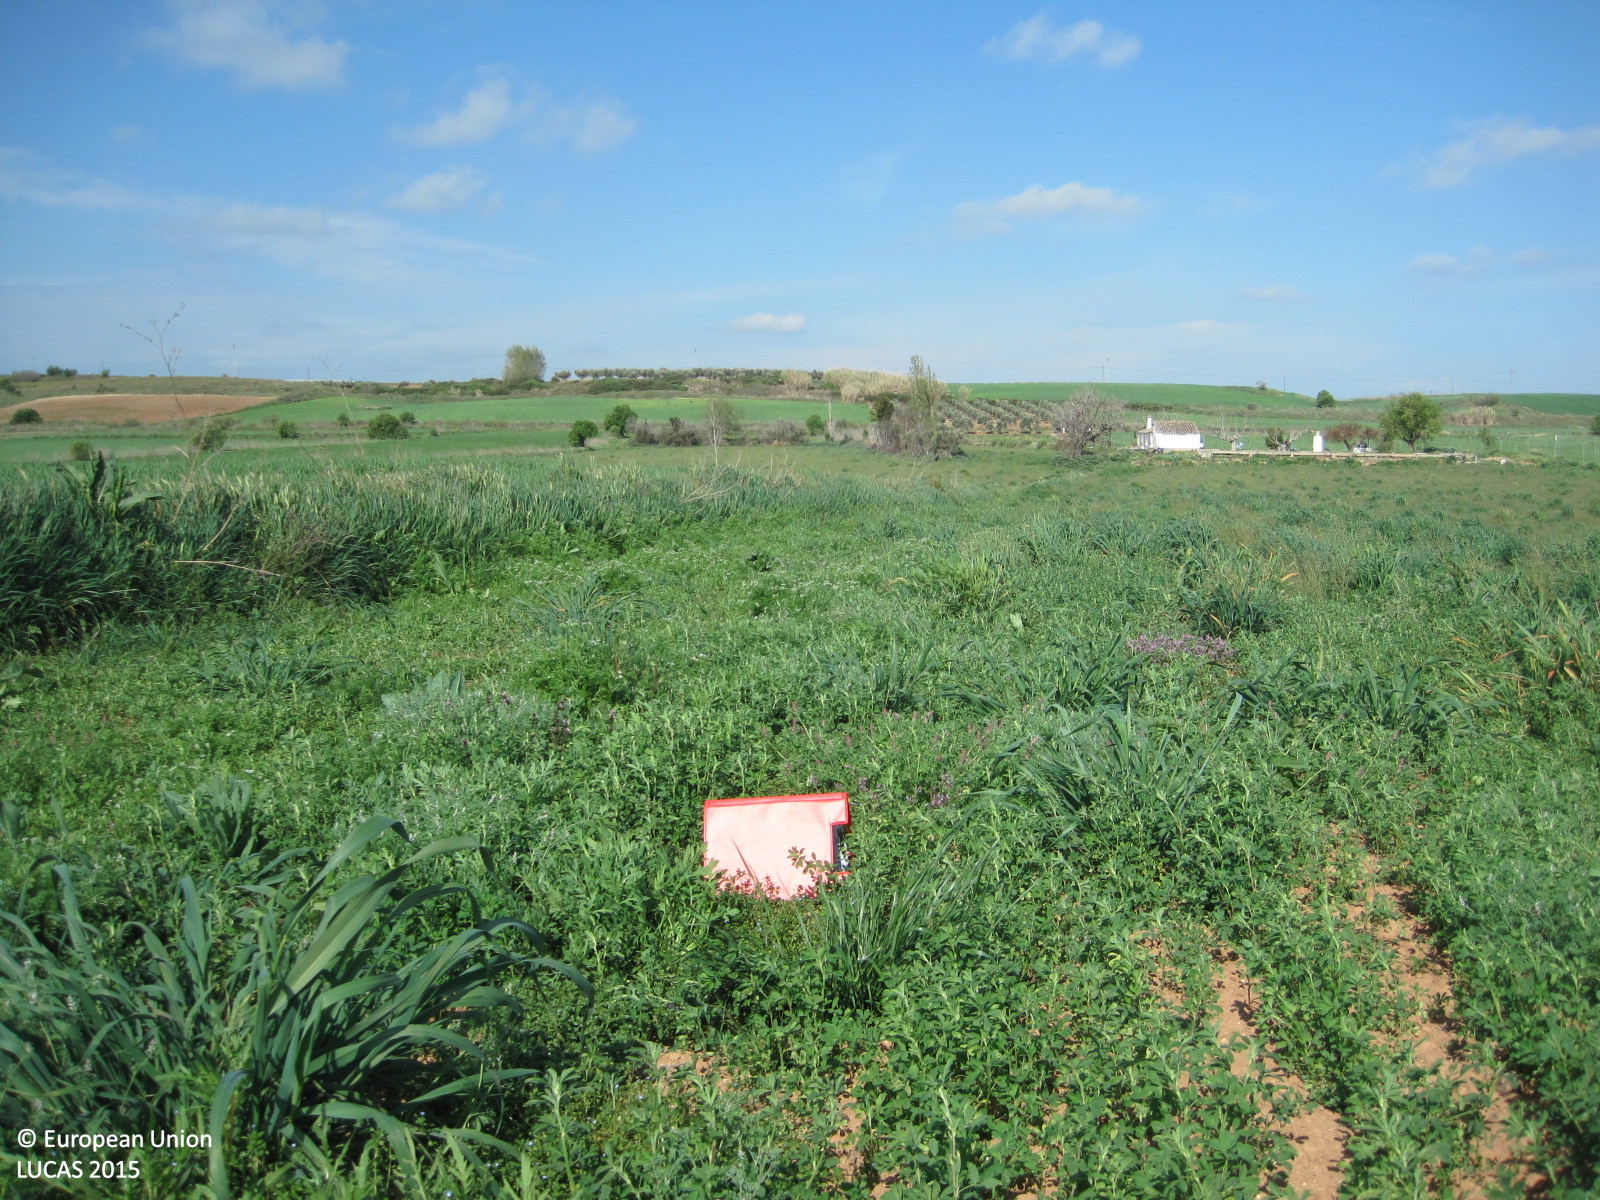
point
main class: Cropland
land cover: Mixed cereals for fodder
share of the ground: > 75 %
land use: Agriculture (excluding fallow land and kitchen gardens)
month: April
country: ES
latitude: 39.8634
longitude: -4.9769
